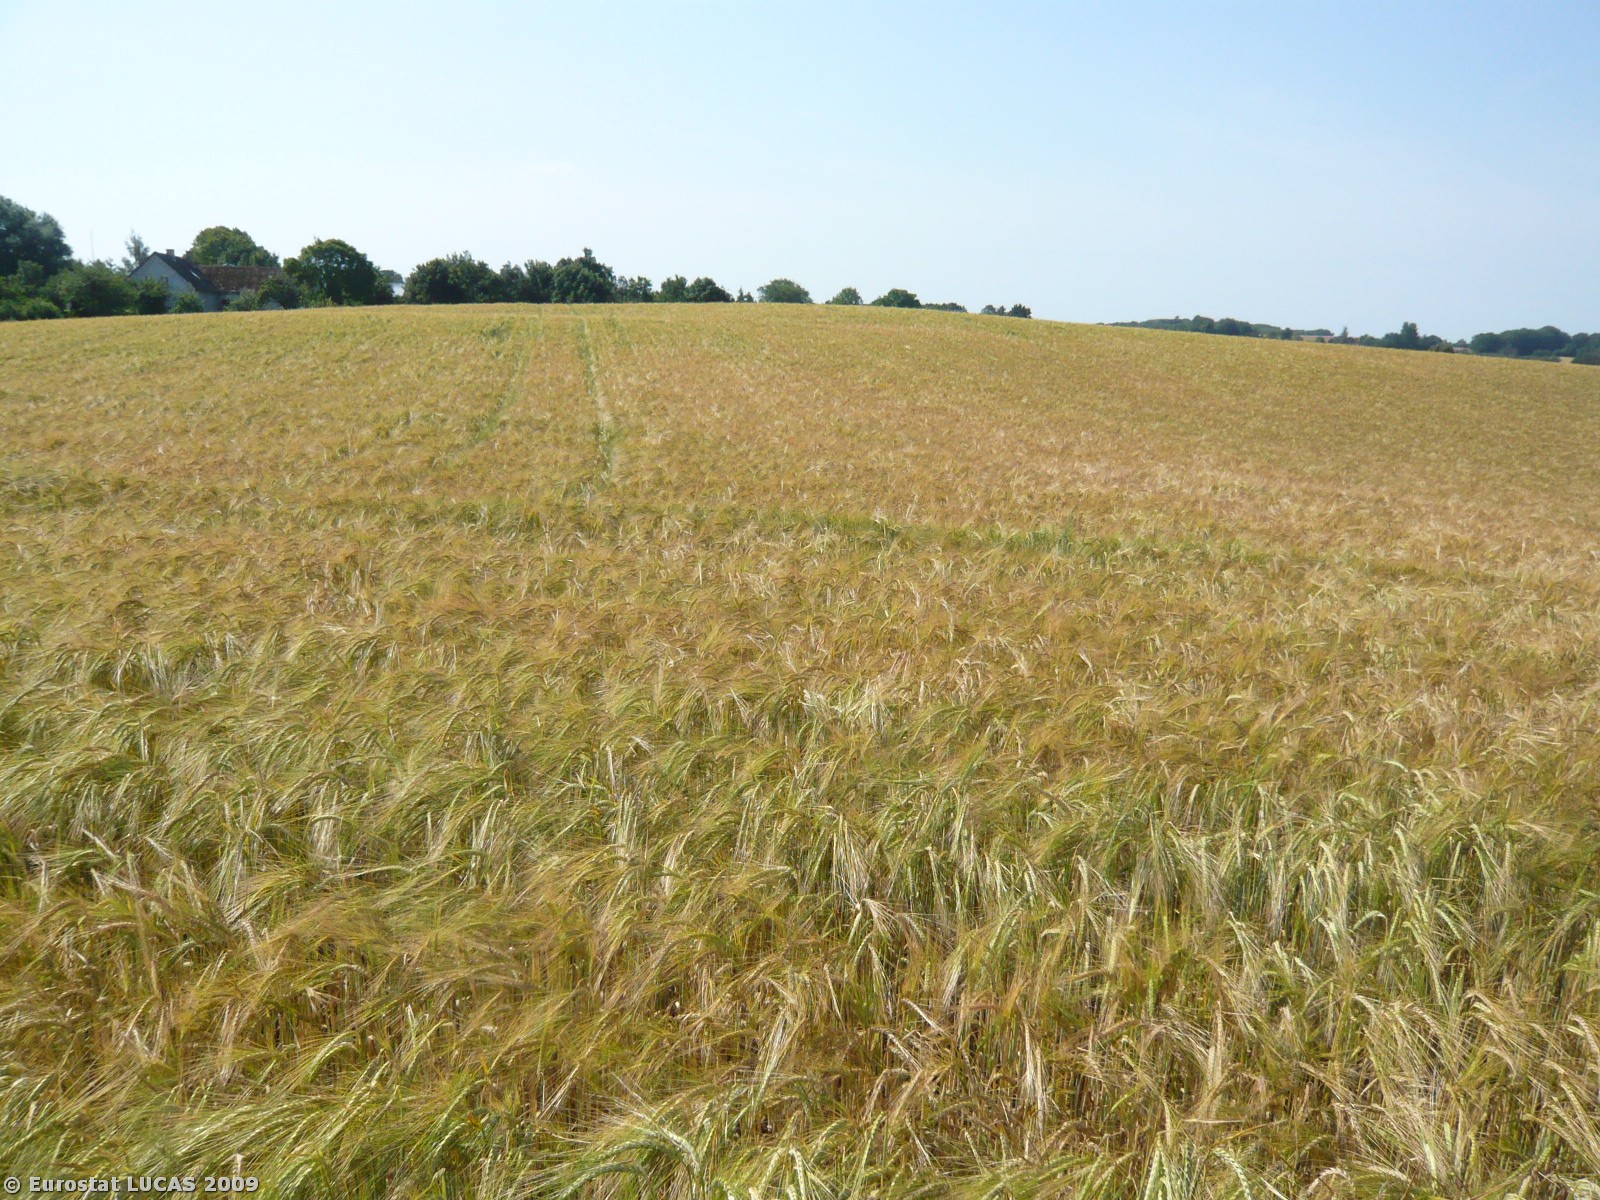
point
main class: Cropland
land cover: Barley
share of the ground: > 75 %
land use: Agriculture (excluding fallow land and kitchen gardens)
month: July
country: DK
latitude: 55.5815
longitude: 11.8227
